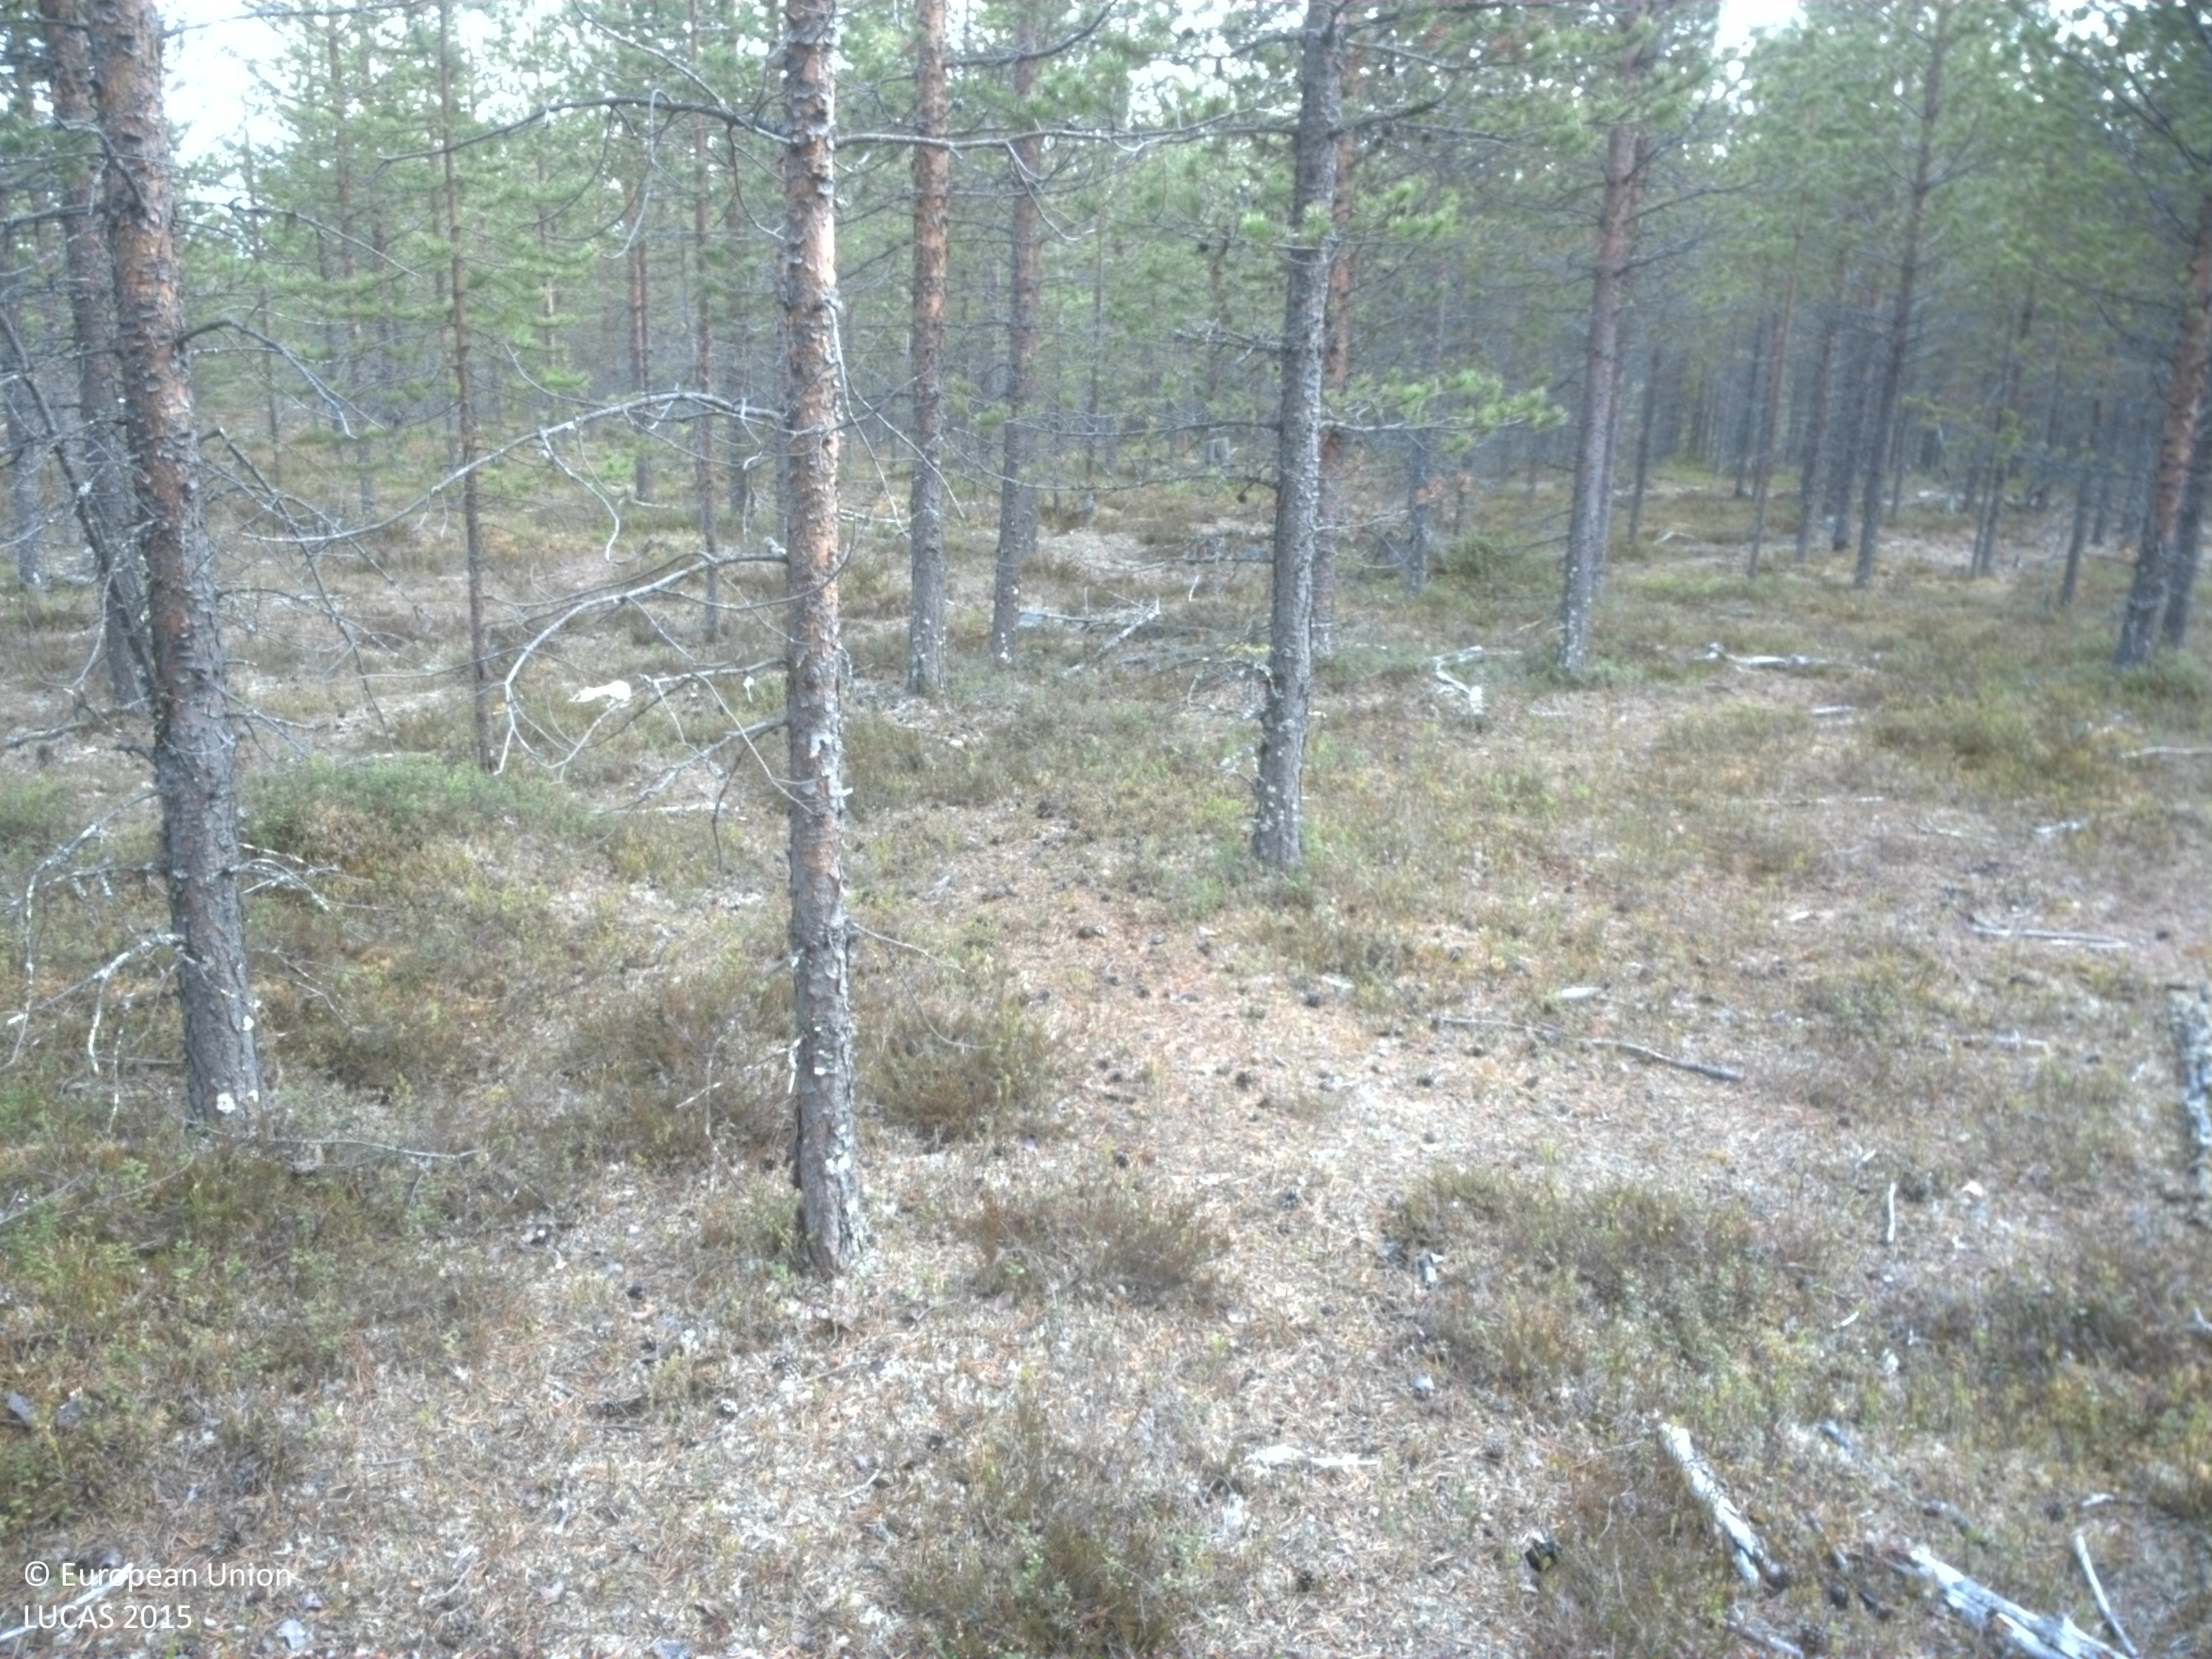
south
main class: Woodland
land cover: Pine dominated coniferous woodland
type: boreal forest
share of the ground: 25 - 50 %
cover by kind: shrubs 40 %, coniferous forest trees 30 %, lichens and mosses 30 %
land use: Forestry
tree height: > 5 m
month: June
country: SE
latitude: 67.0065
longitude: 21.9577
